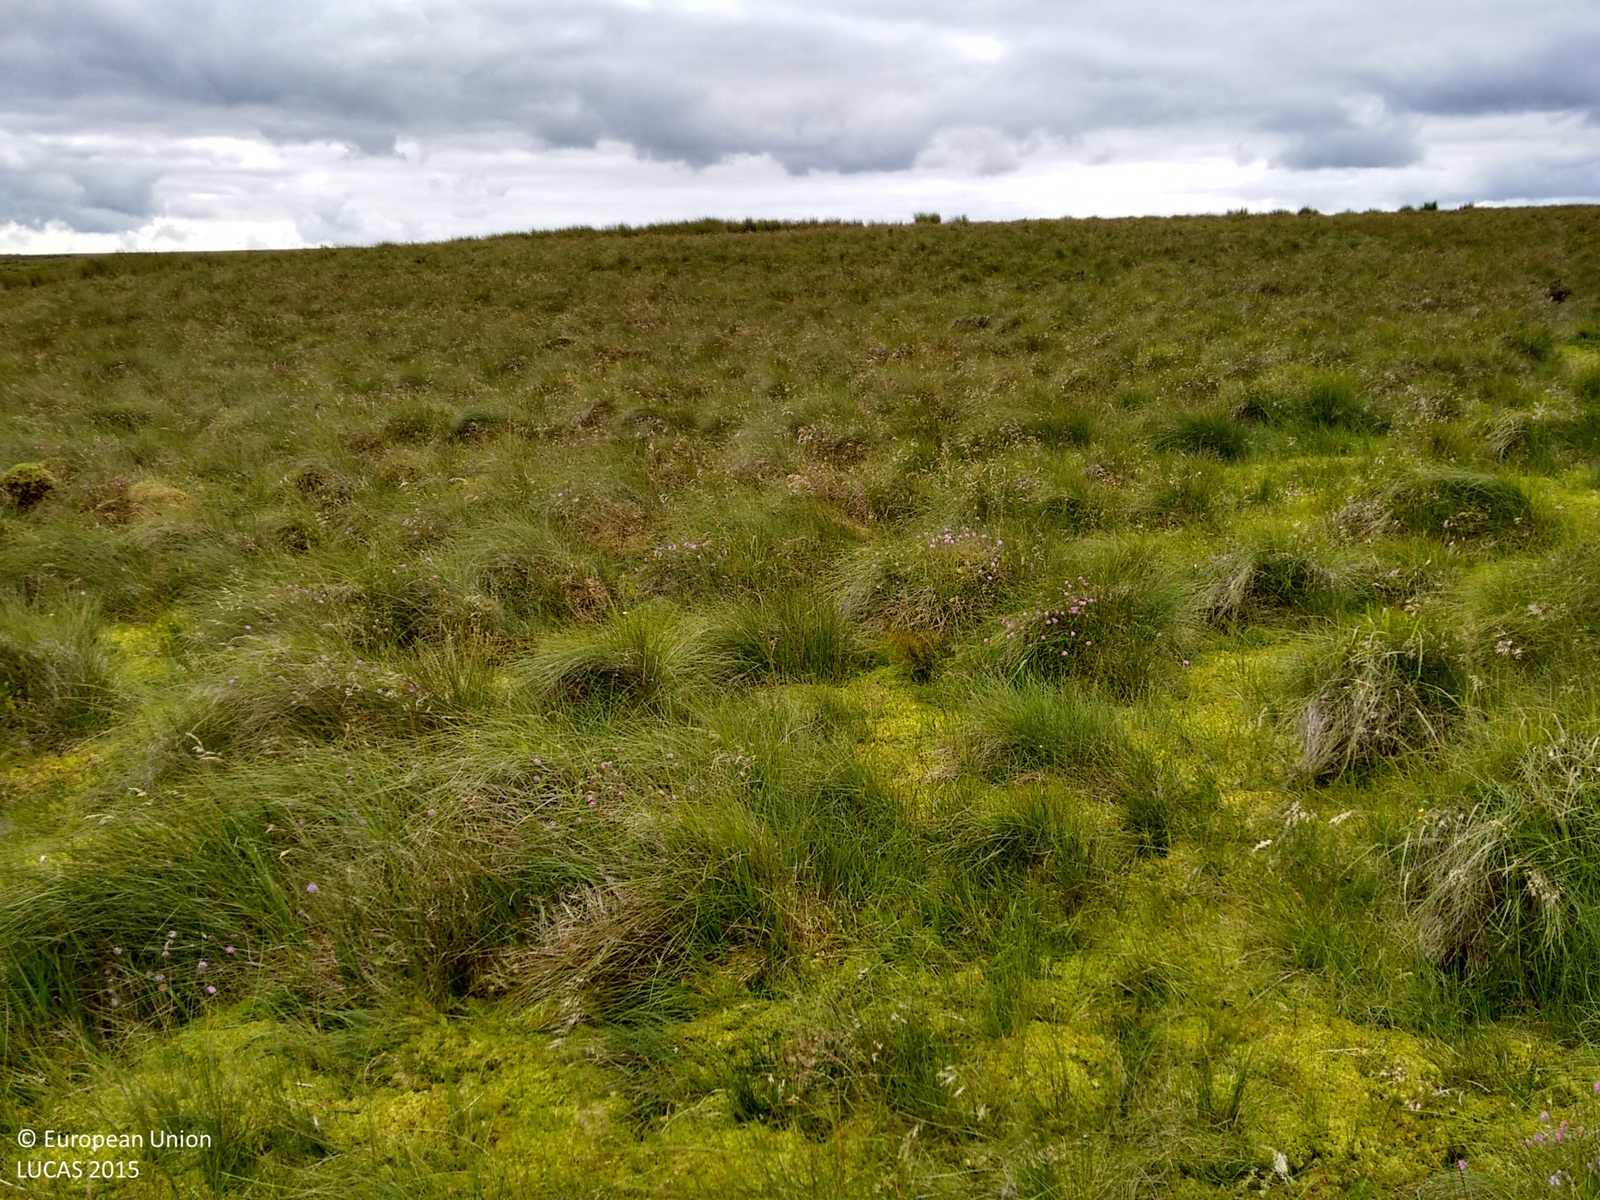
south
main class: Grassland
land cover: Grassland without tree/shrub cover
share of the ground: > 75 %
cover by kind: herbaceous plants 70 %, lichens and mosses 30 %
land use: Agriculture (excluding fallow land and kitchen gardens)
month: August
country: GB
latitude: 55.0012
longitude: -4.8843
